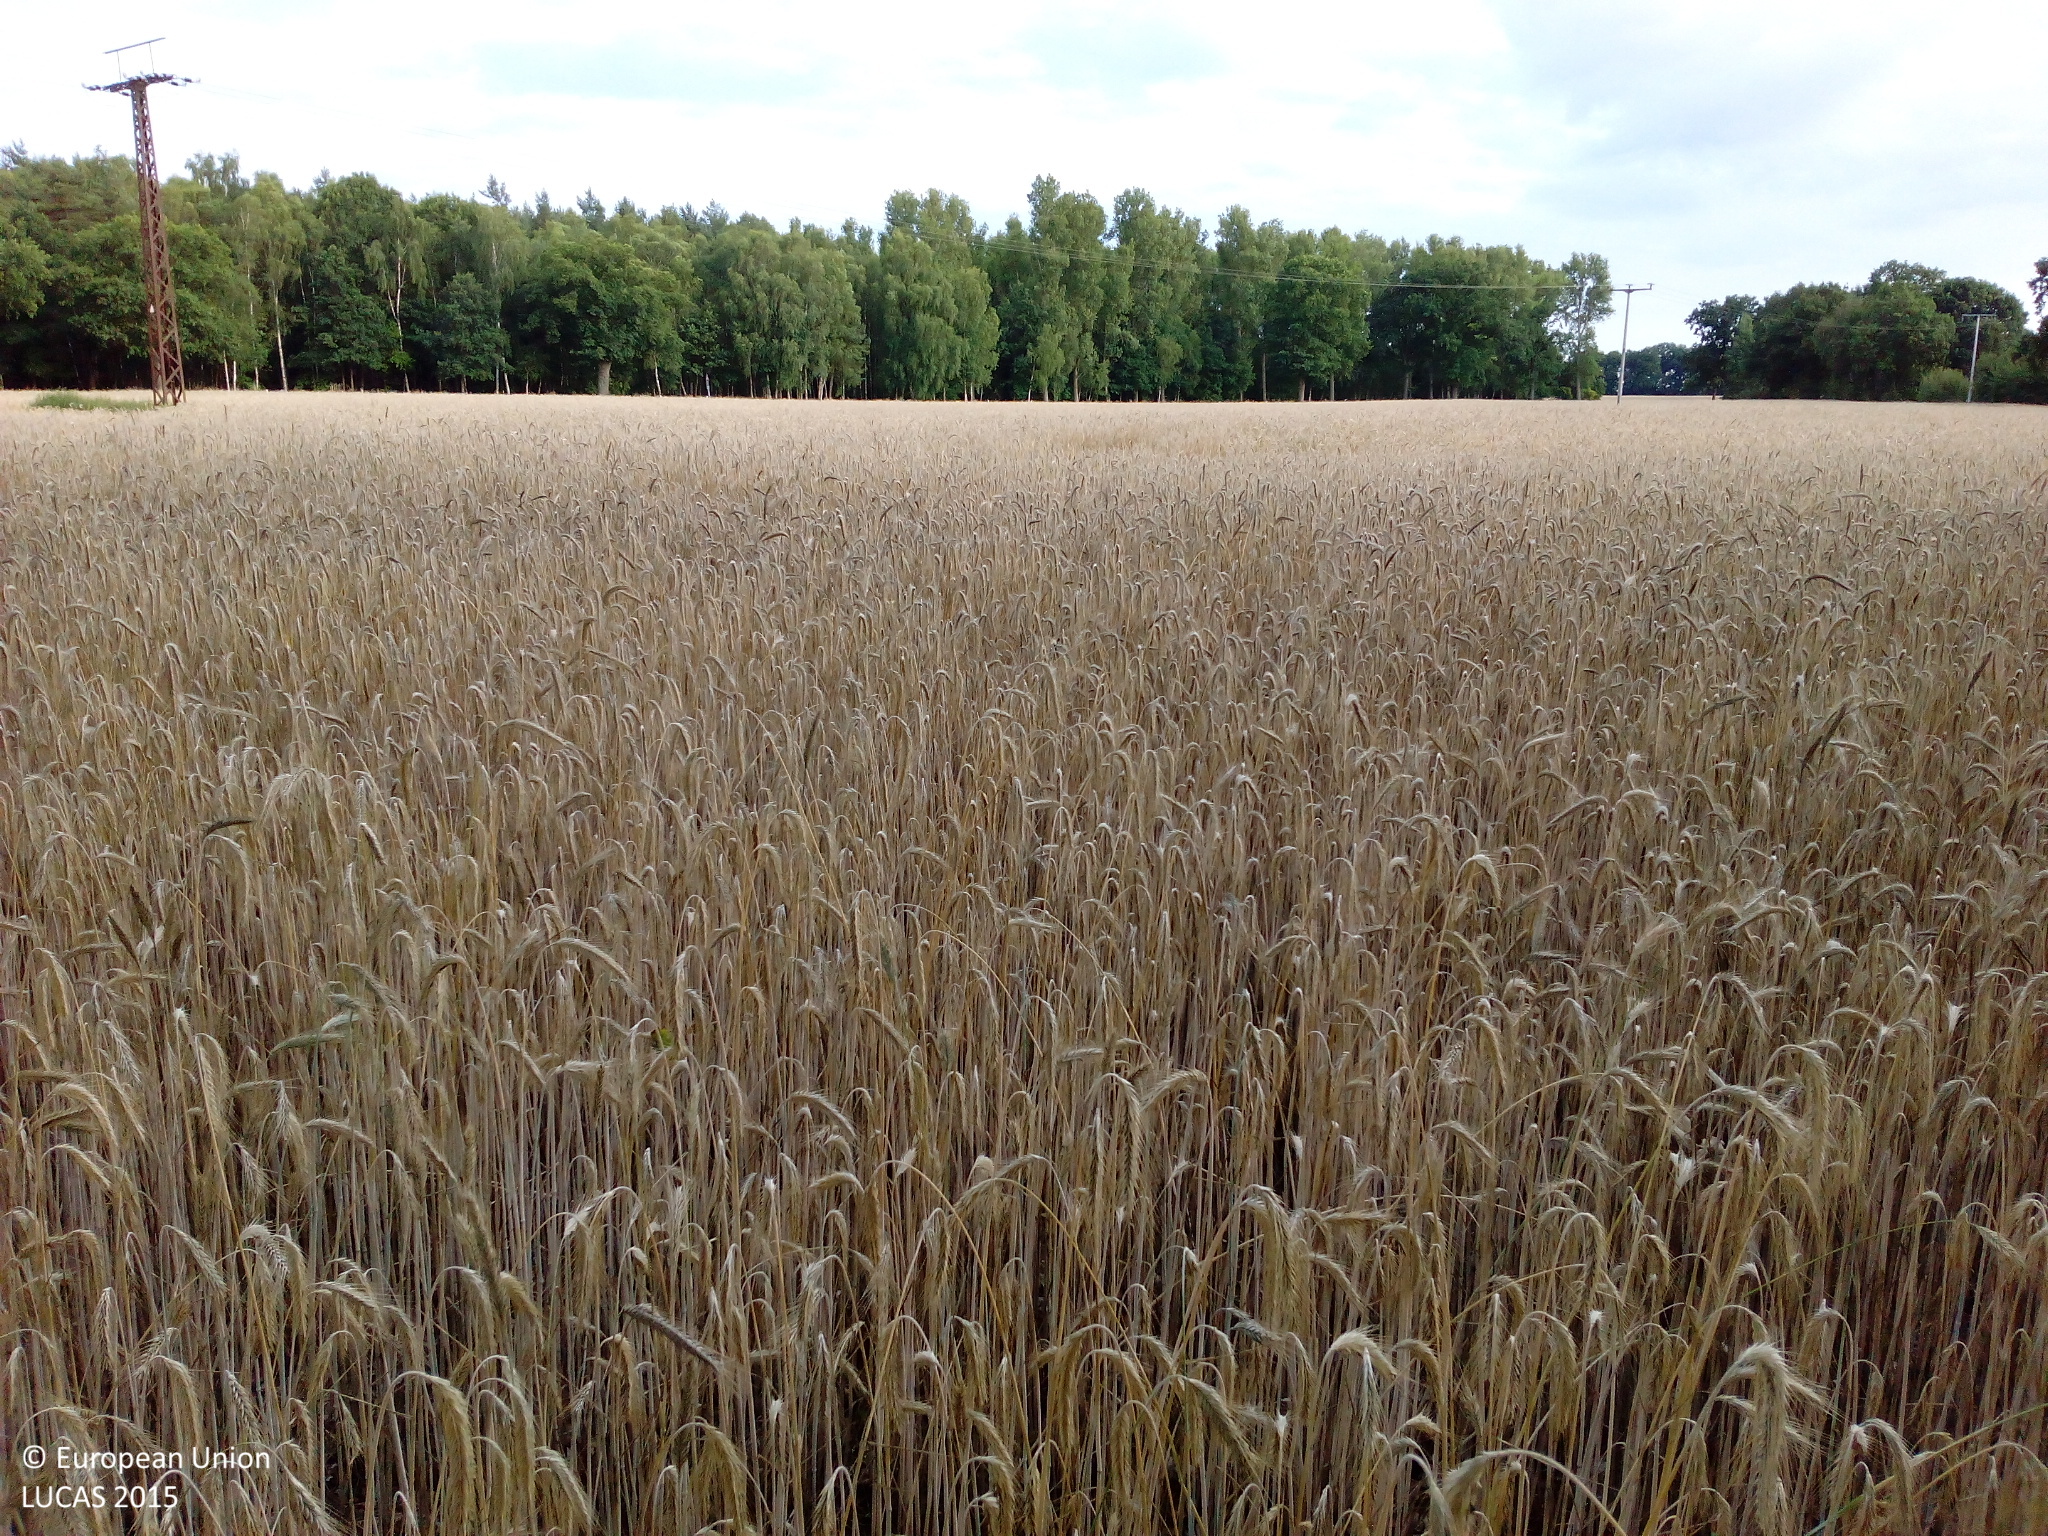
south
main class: Cropland
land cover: Rye
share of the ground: > 75 %
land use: Agriculture (excluding fallow land and kitchen gardens)
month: July
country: DE
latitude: 52.9641
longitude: 12.4262
